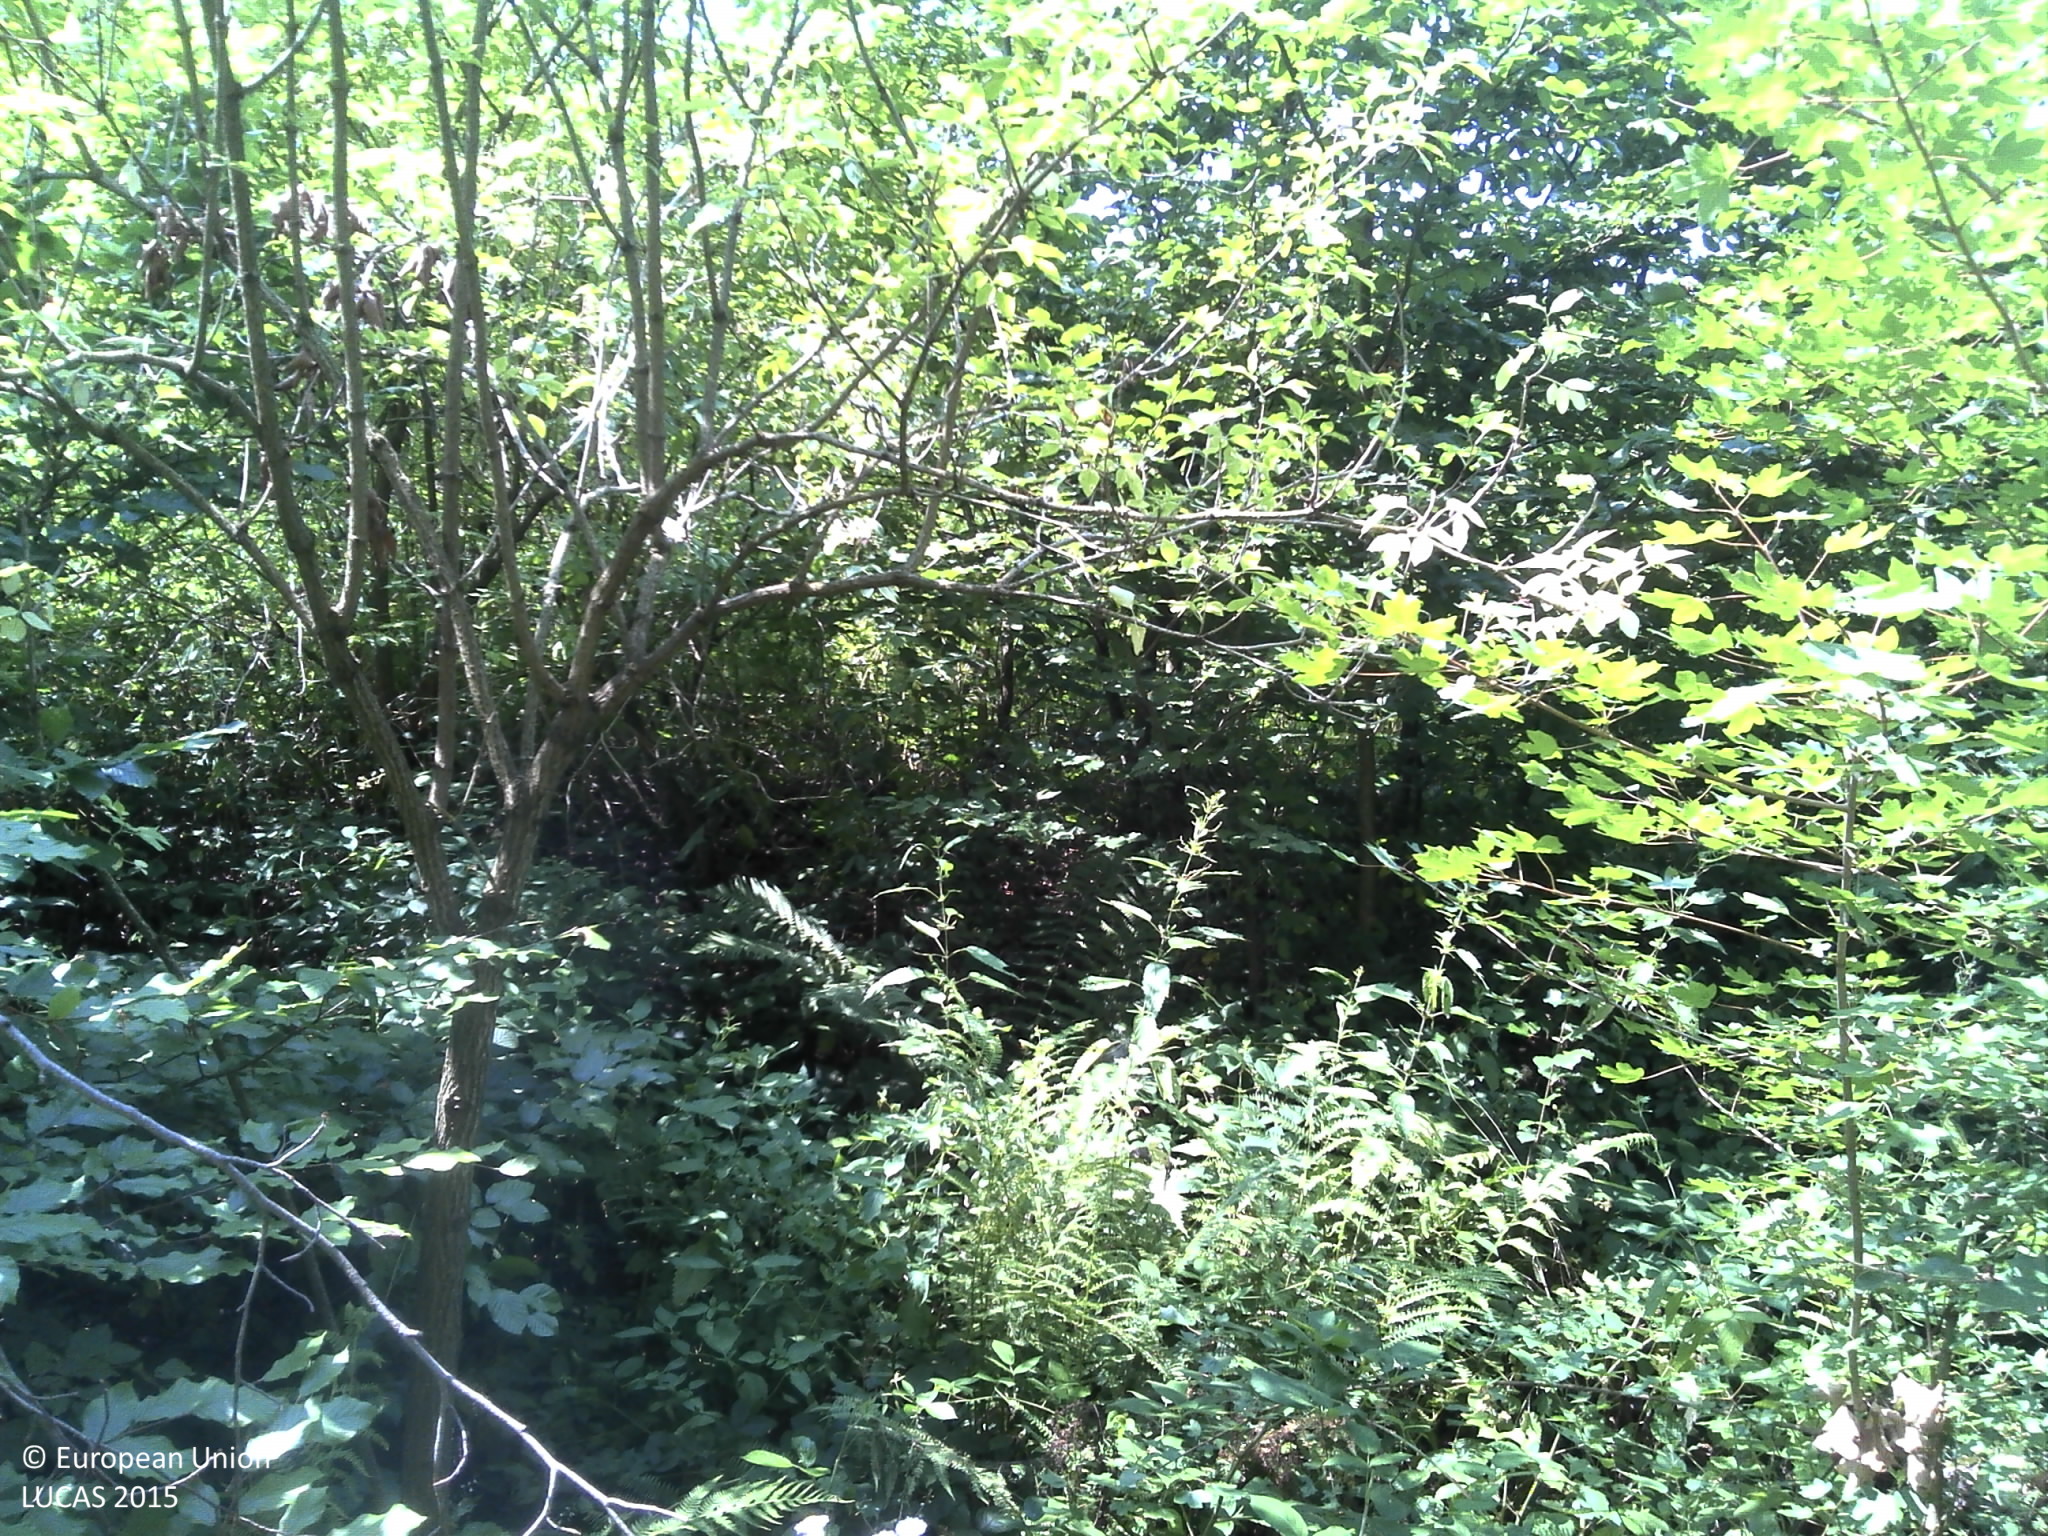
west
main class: Woodland
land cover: Broadleaved woodland
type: beech forest
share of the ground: > 75 %
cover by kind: broadleaved forest trees 100 %
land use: Forestry
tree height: > 5 m
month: July
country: HR
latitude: 45.6581
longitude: 17.1748
